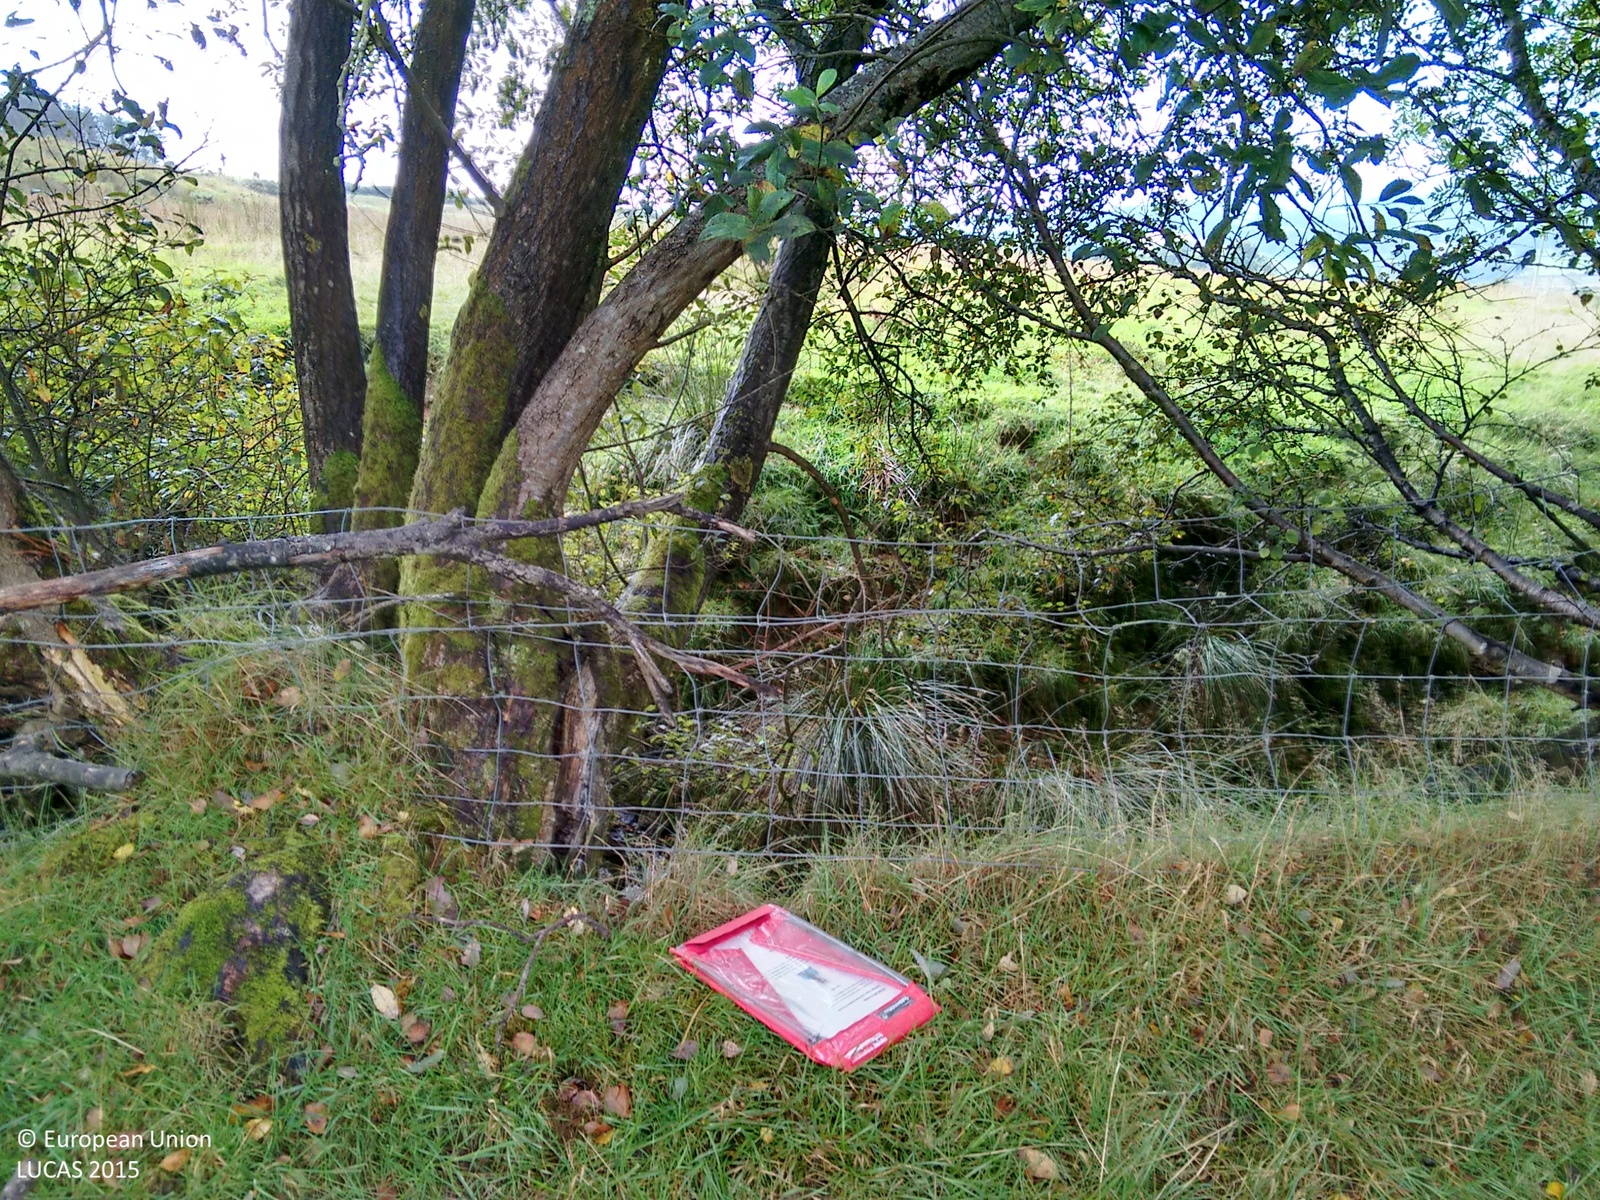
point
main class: Grassland
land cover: Grassland without tree/shrub cover
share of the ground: > 75 %
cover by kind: herbaceous plants 100 %
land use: Agriculture (excluding fallow land and kitchen gardens)
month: September
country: GB
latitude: 52.1879
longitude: -3.9455
